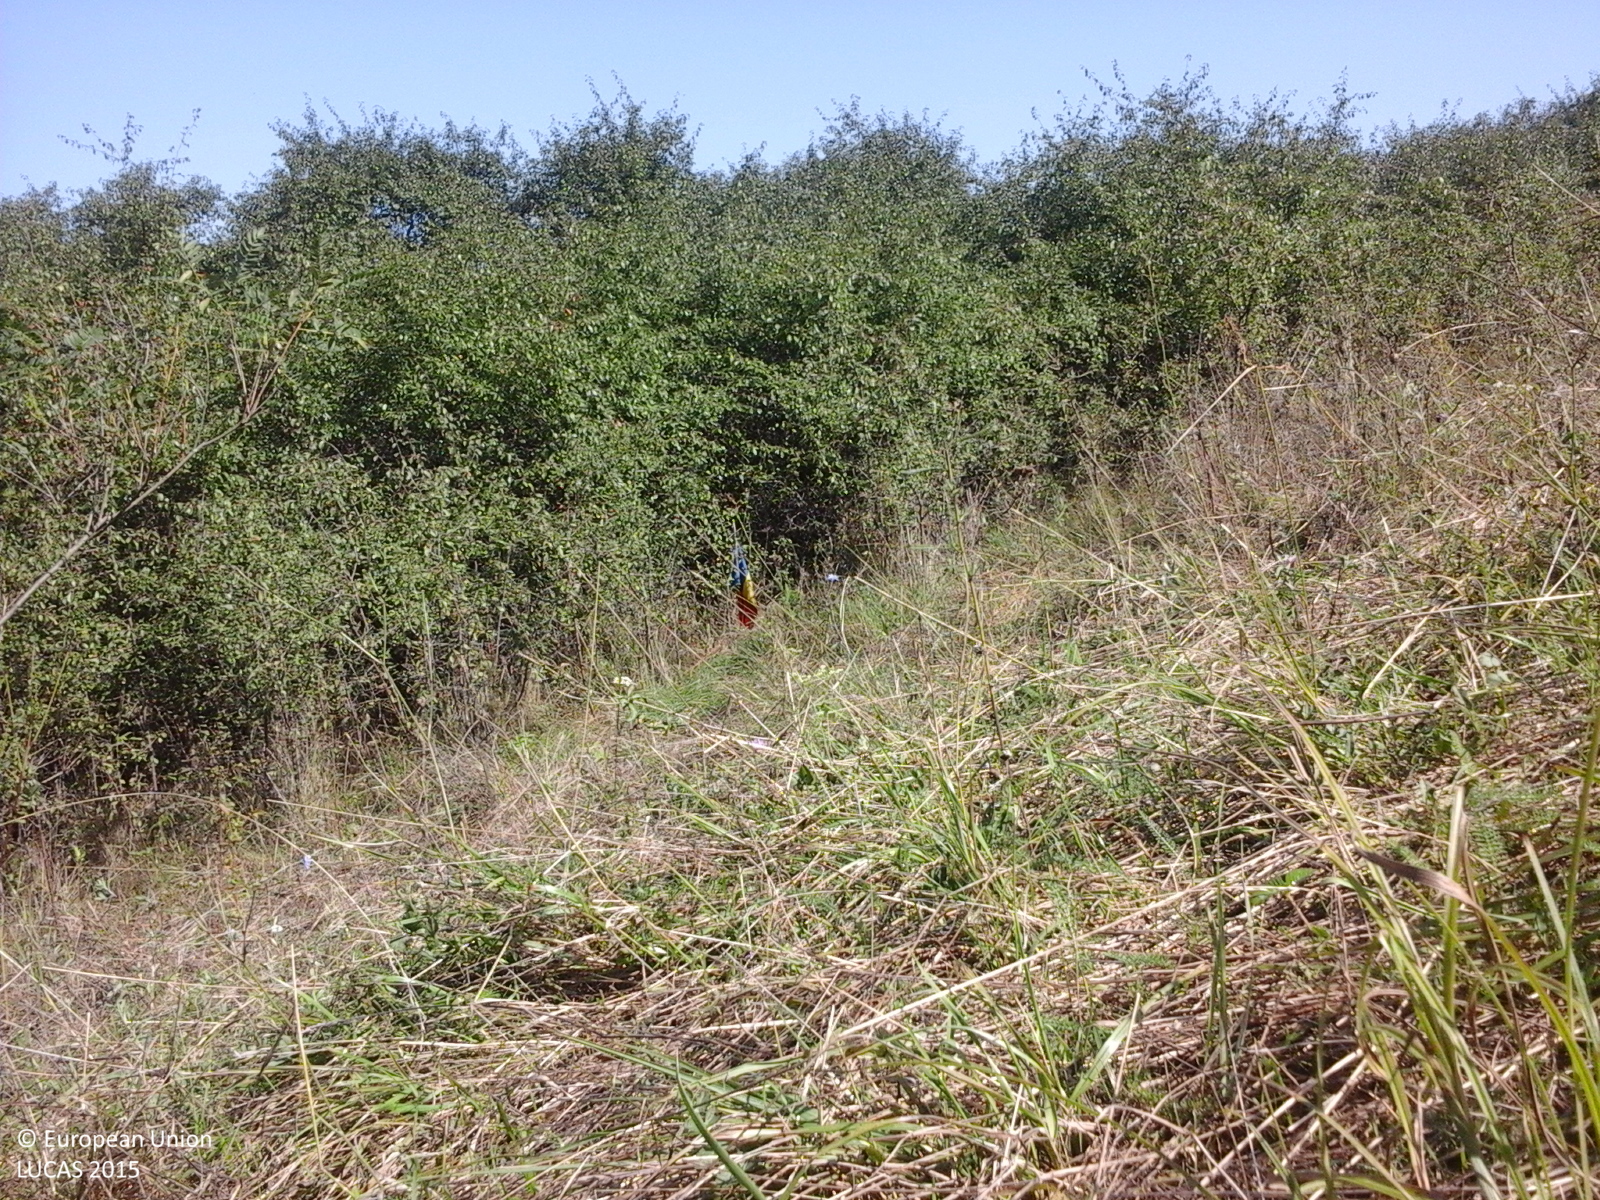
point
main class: Shrubland
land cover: Shrubland with sparse tree cover
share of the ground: > 75 %
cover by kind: shrubs 95 %, broadleaved forest trees 5 %
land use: Semi-natural and natural areas not in use
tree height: < 5 m
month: August
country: RO
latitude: 45.6609
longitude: 21.2863
